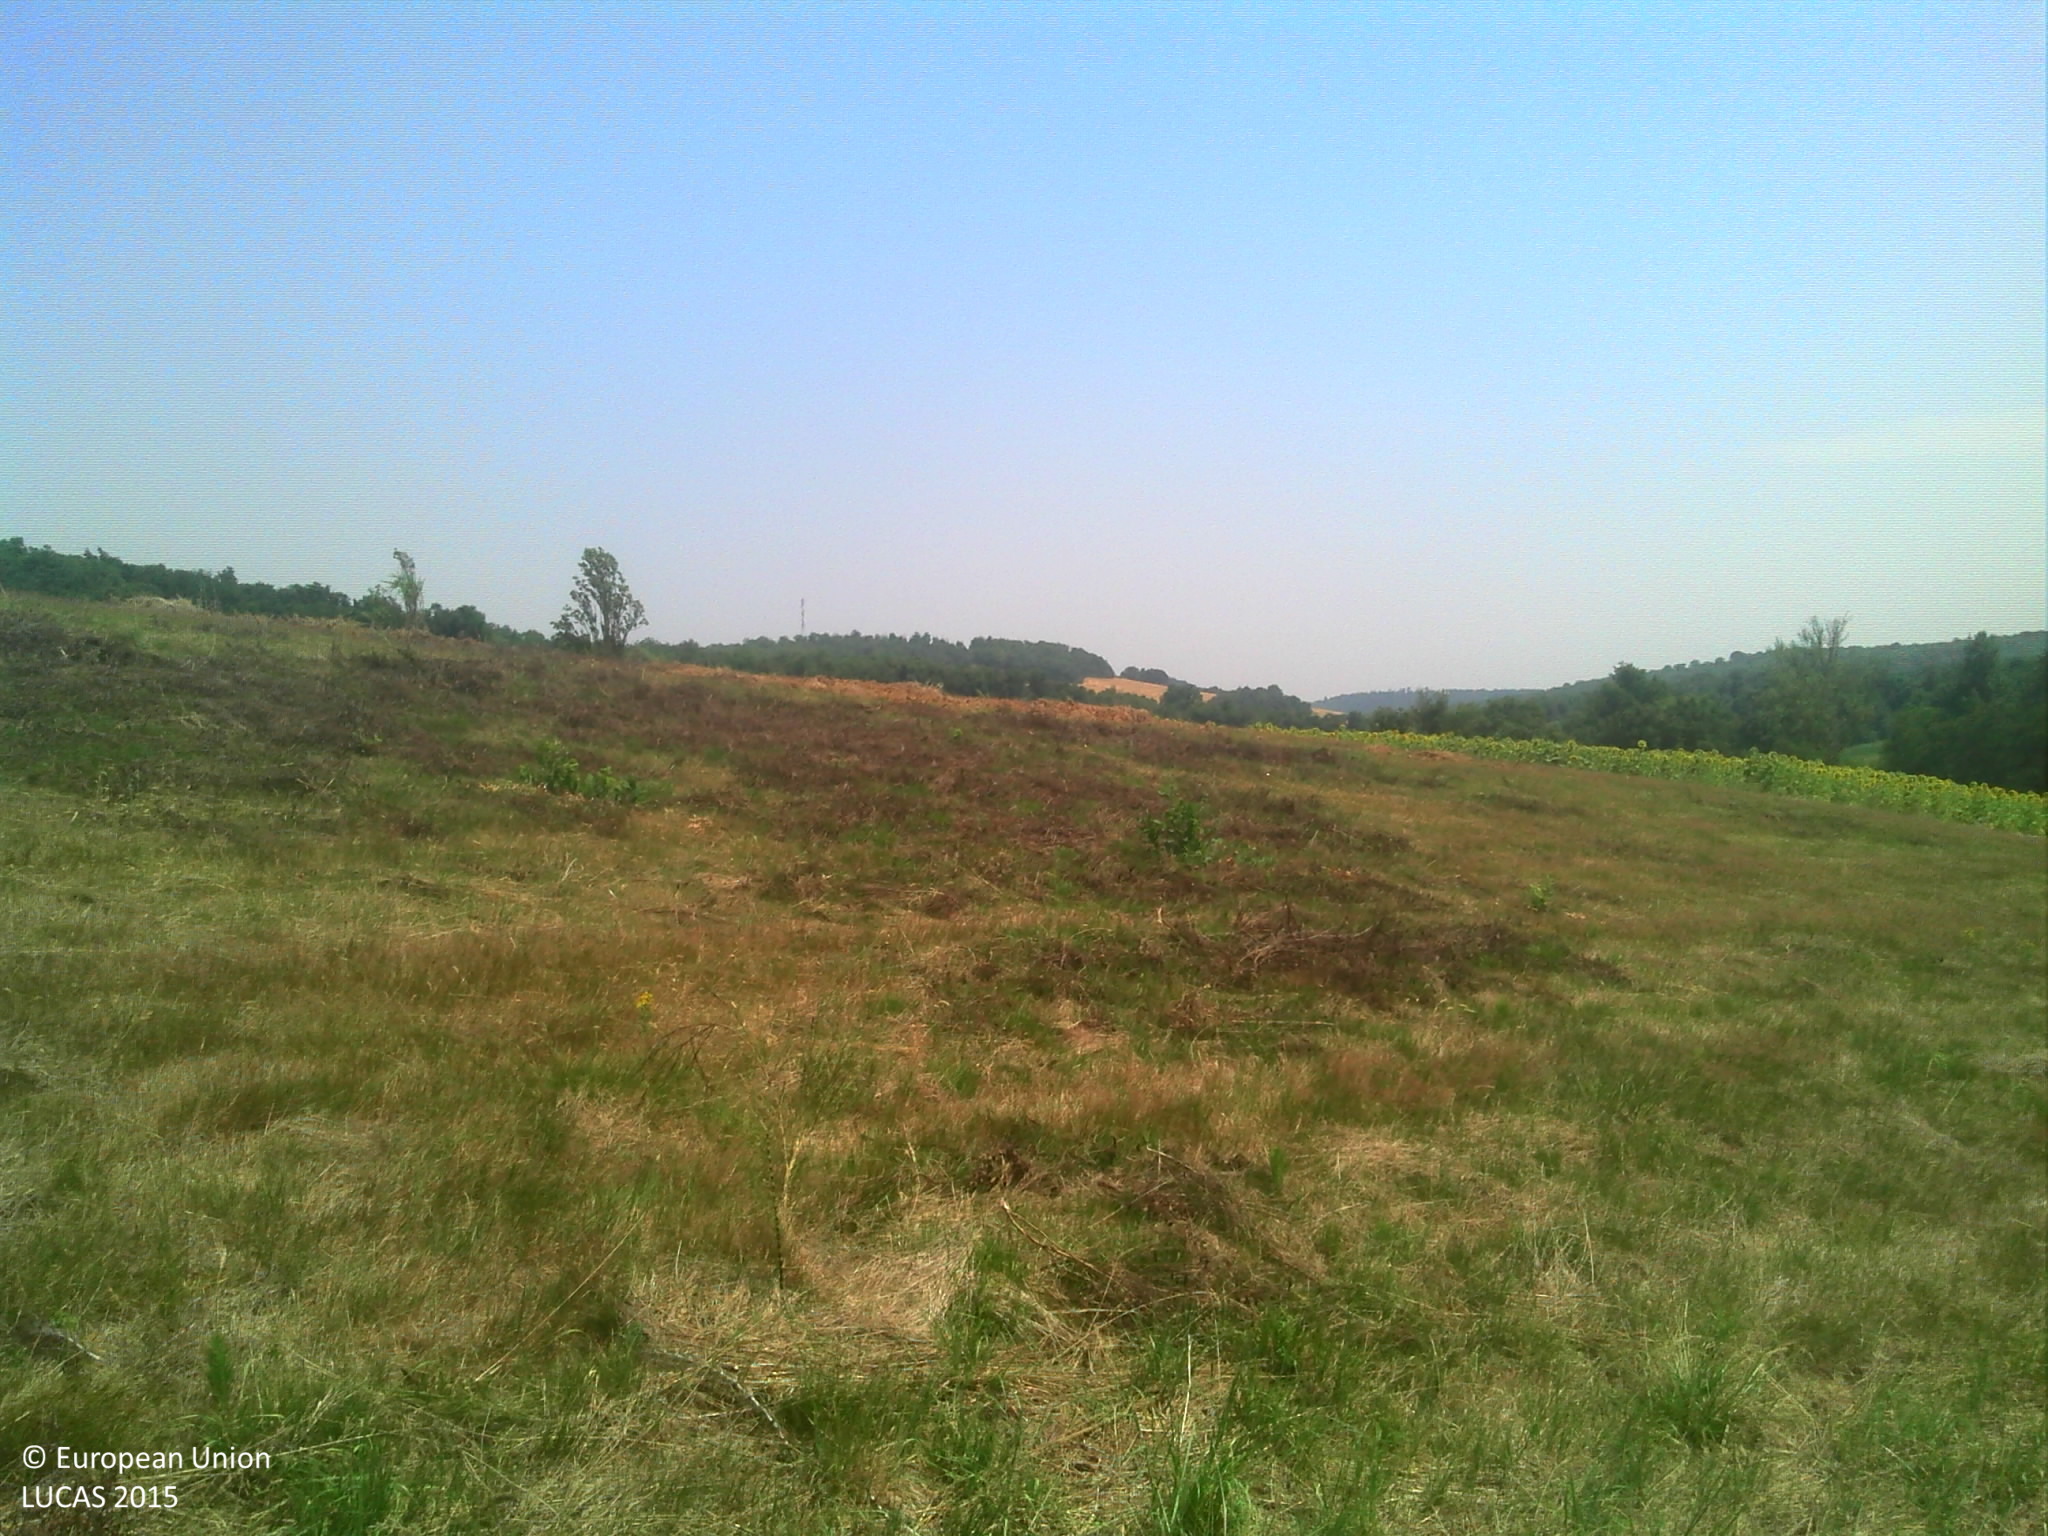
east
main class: Grassland
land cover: Grassland without tree/shrub cover
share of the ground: > 75 %
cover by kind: herbaceous plants 100 %
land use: Agriculture (excluding fallow land and kitchen gardens)
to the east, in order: Grassland without tree/shrub cover; Sunflower; Grass margins; Common wheat; Abandoned hedges; Ditches and canals; Abandoned hedges; Soya
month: July
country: FR
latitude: 43.3807
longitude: 1.0283
